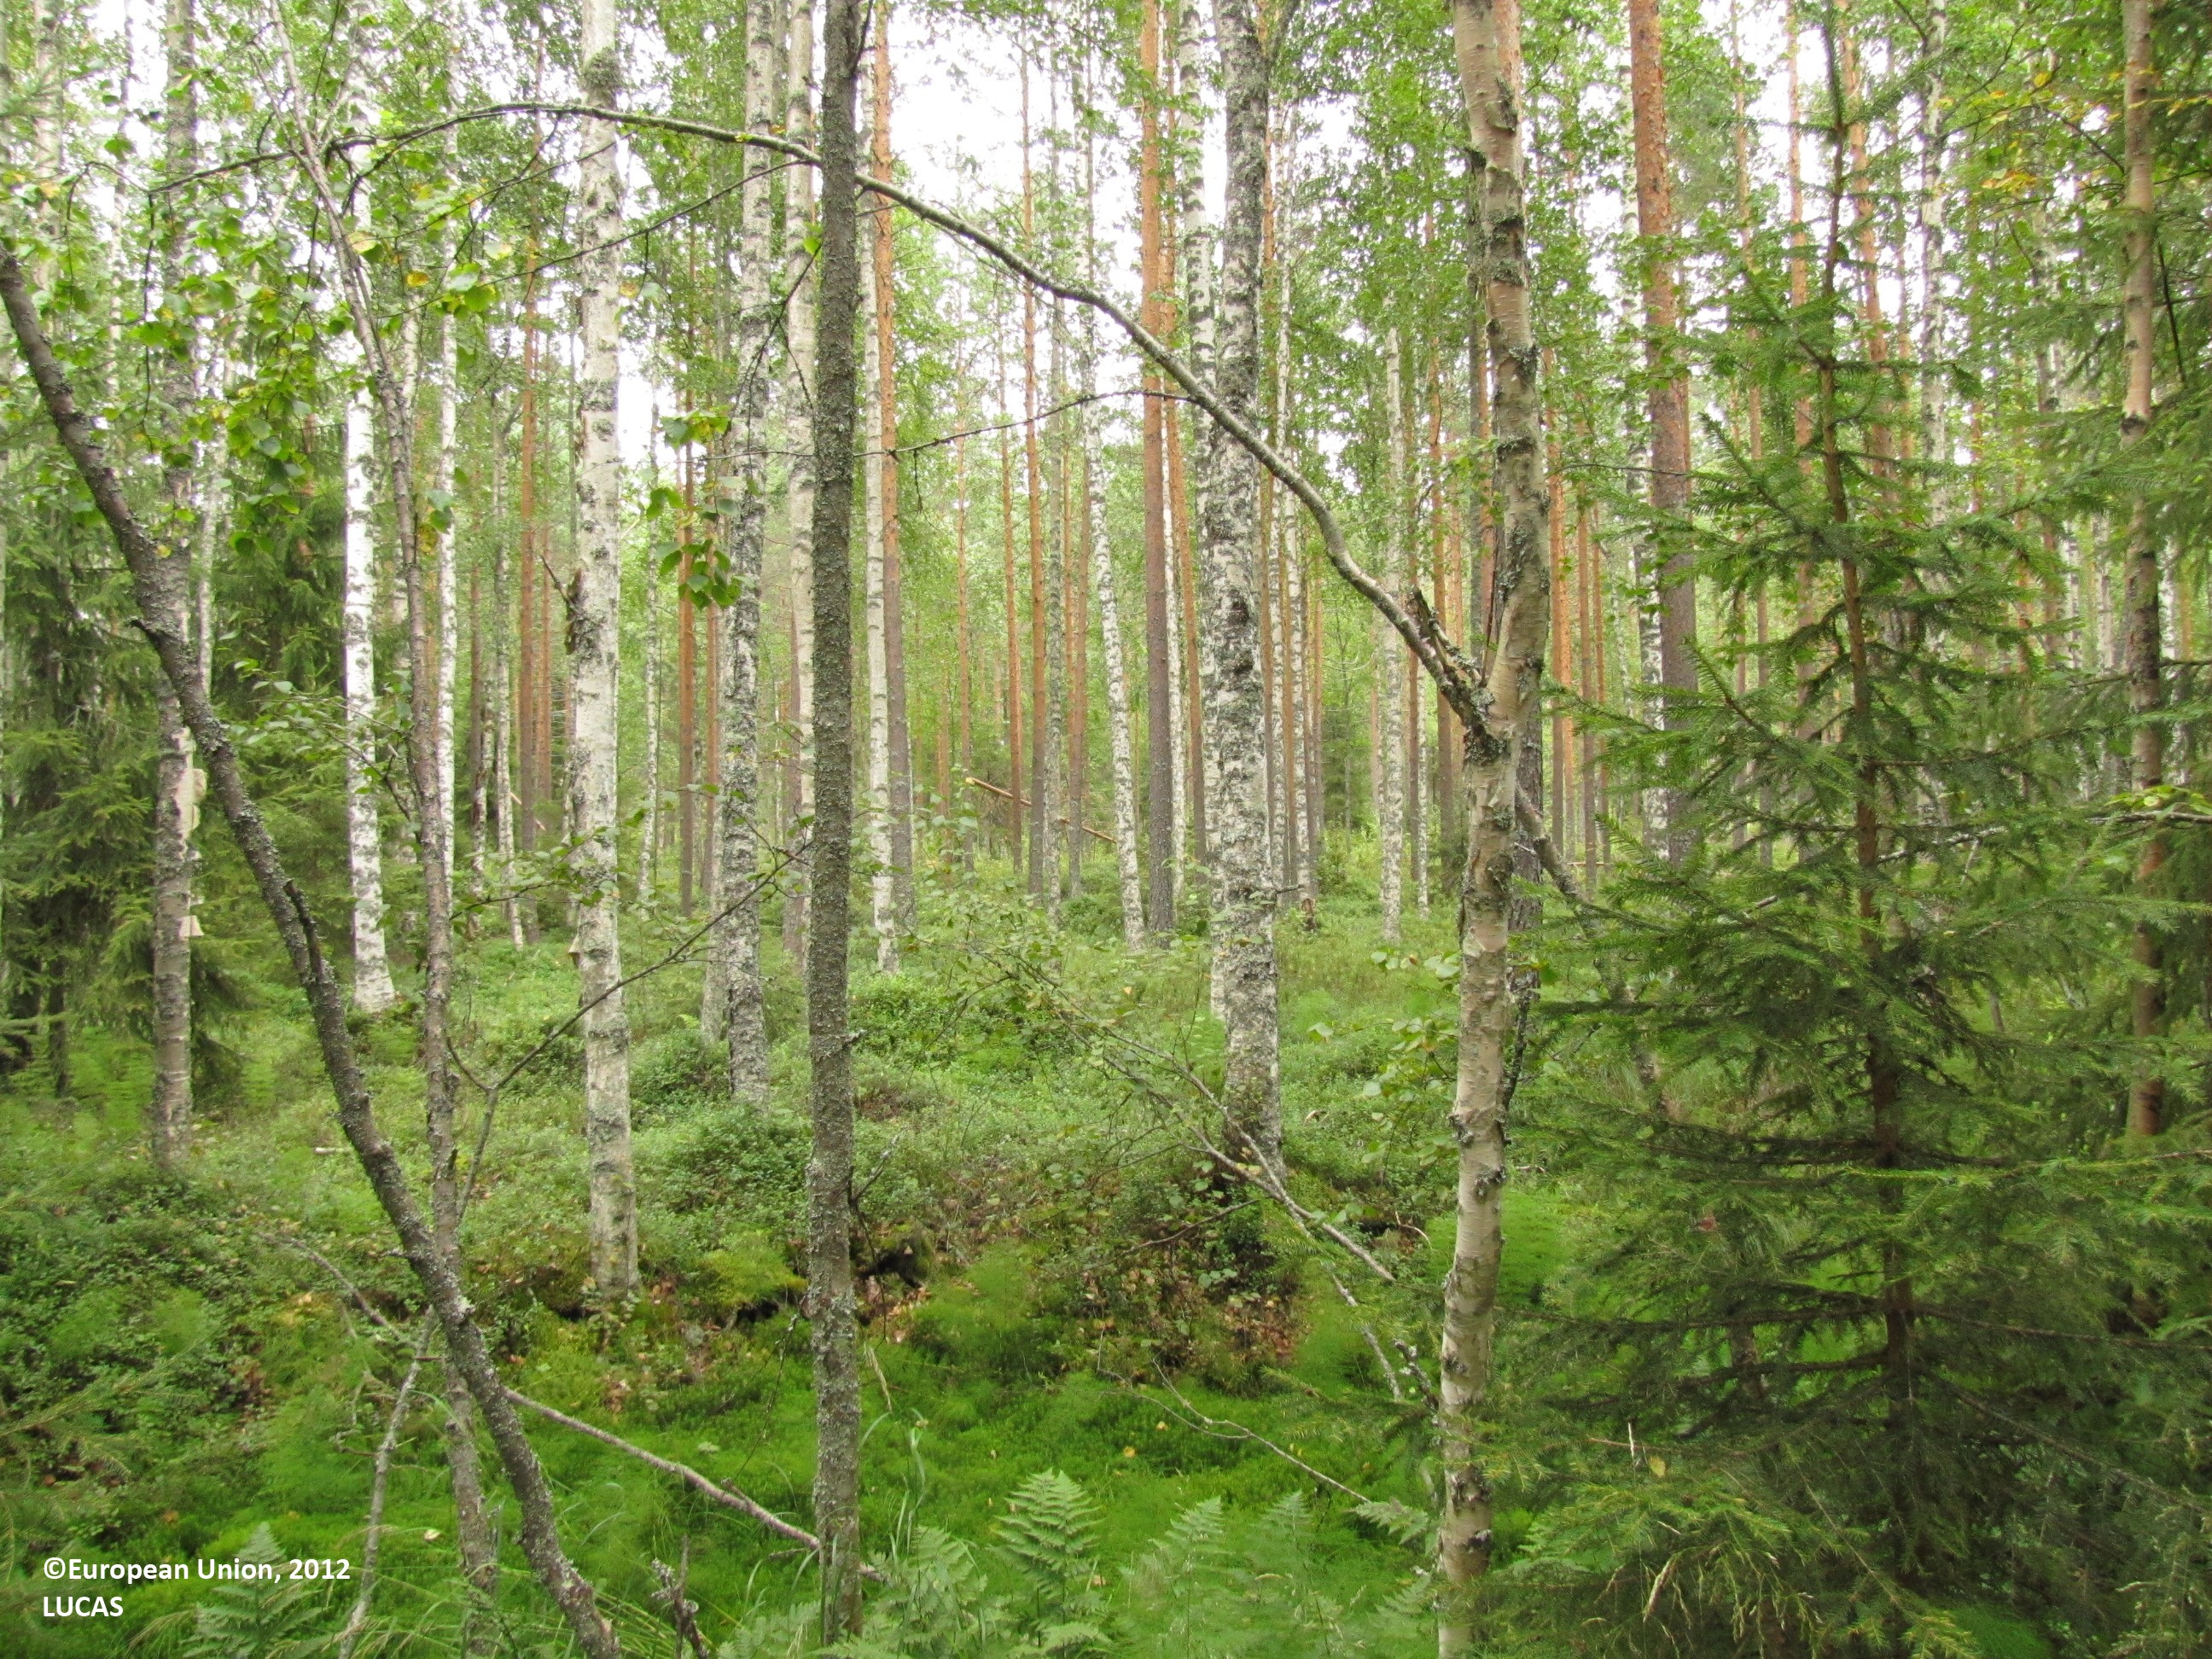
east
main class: Woodland
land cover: Broadleaved woodland
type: mire and swamp forests
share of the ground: 50 - 75 %
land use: Forestry
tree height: > 5 m
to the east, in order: Broadleaved woodland; Ditches and canals; Pine dominated mixed woodland; Ditches and canals; Pine dominated coniferous woodland; Ditches and canals; Spruce dominated coniferous woodland; Spruce dominated mixed woodland
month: August
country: FI
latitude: 61.9211
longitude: 22.9603
